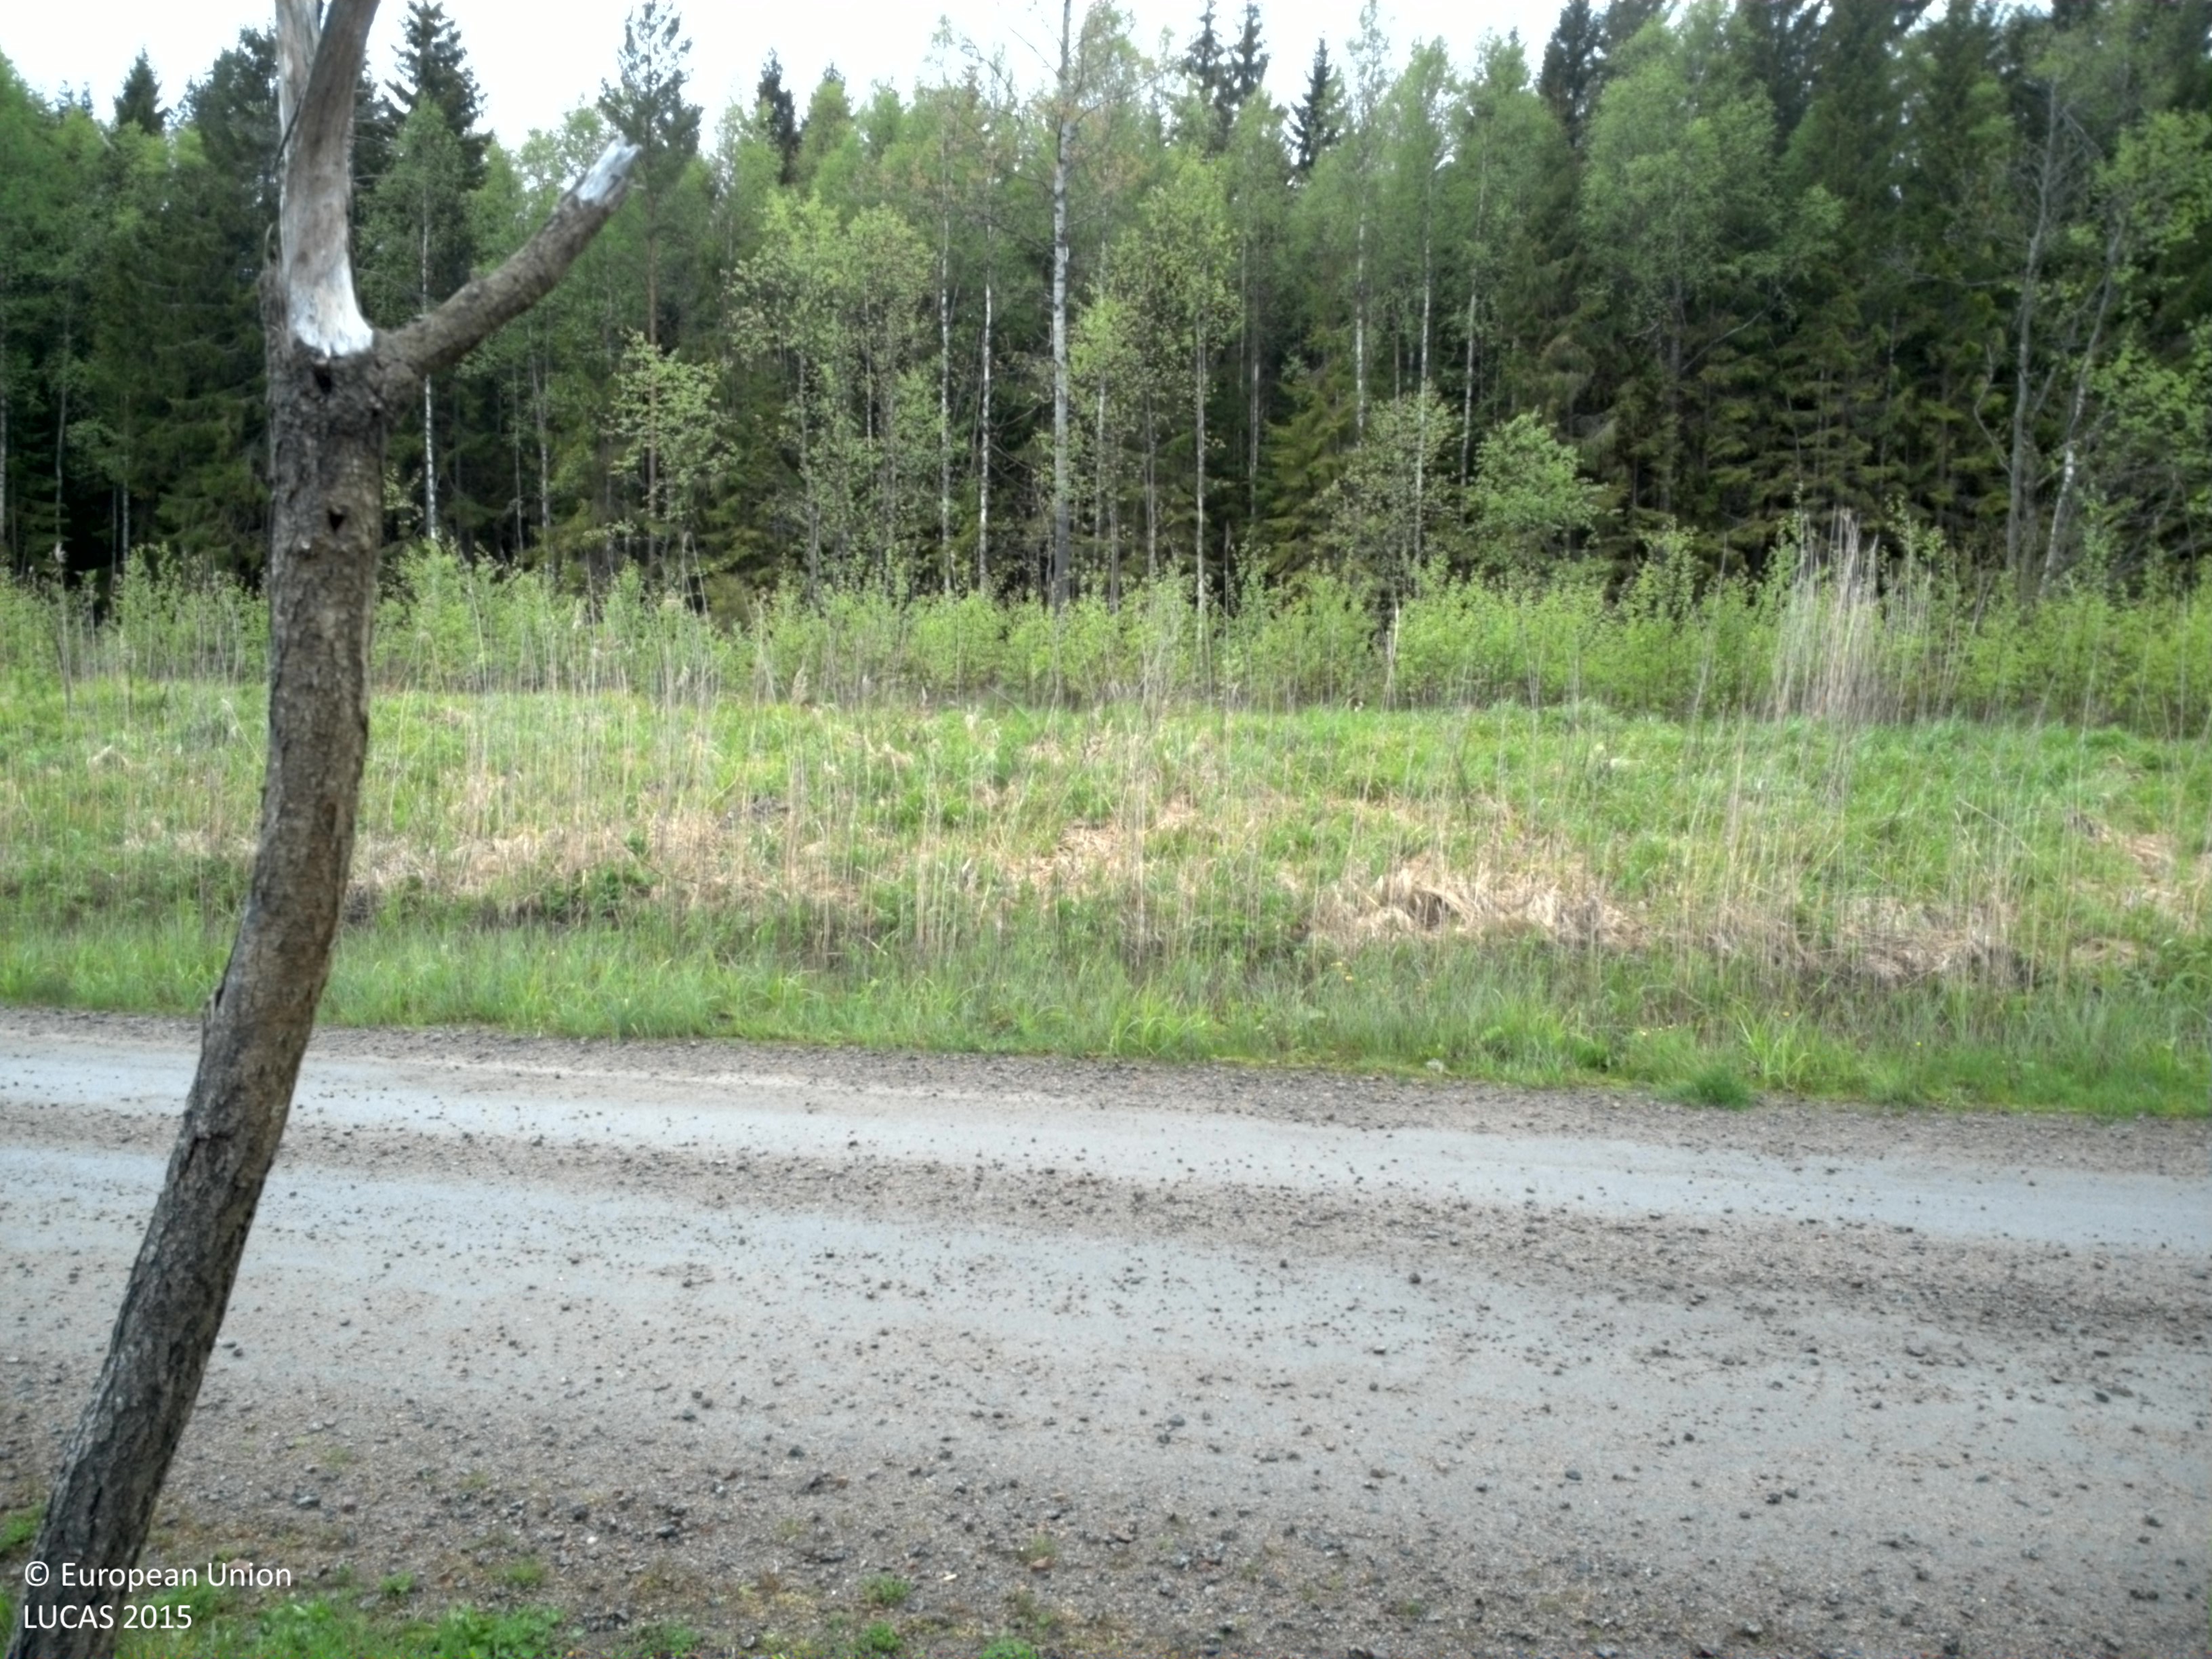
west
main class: Woodland
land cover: Broadleaved woodland
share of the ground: 25 - 50 %
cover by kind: herbaceous plants 40 %, broadleaved forest trees 35 %, lichens and mosses 15 %, coniferous forest trees 5 %, shrubs 5 %
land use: Forestry
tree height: > 5 m
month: May
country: SE
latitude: 59.3623
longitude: 14.1610
